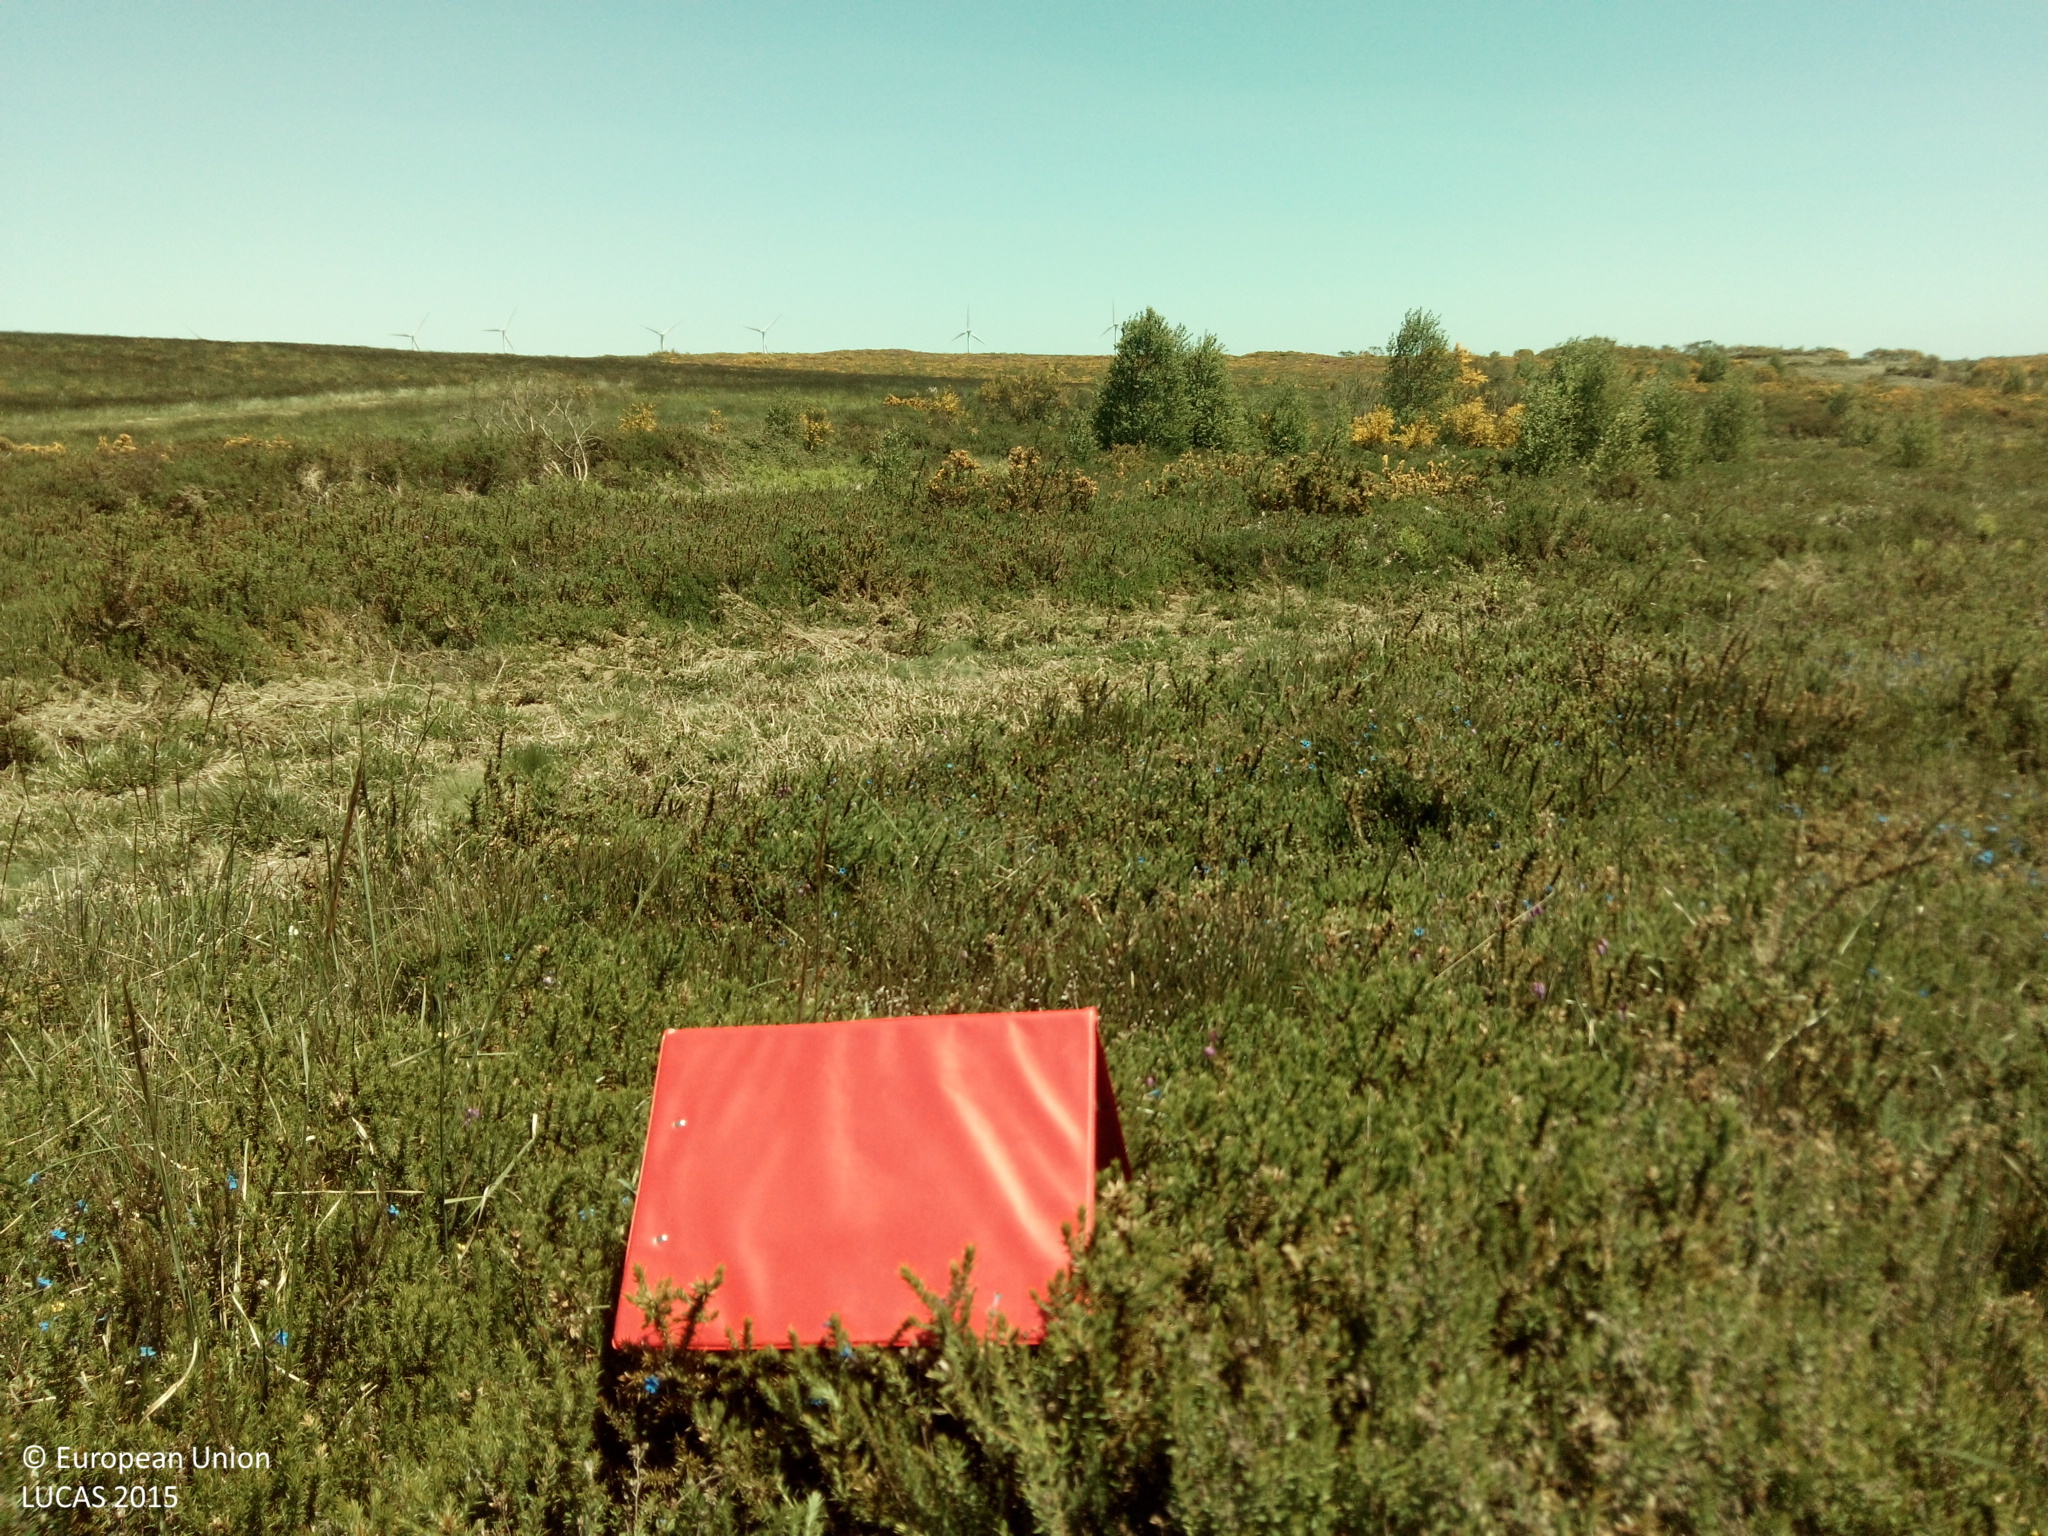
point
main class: Shrubland
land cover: Shrubland without tree cover
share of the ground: > 75 %
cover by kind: shrubs 100 %
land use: Semi-natural and natural areas not in use
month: May
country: ES
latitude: 42.6757
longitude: -8.3639
